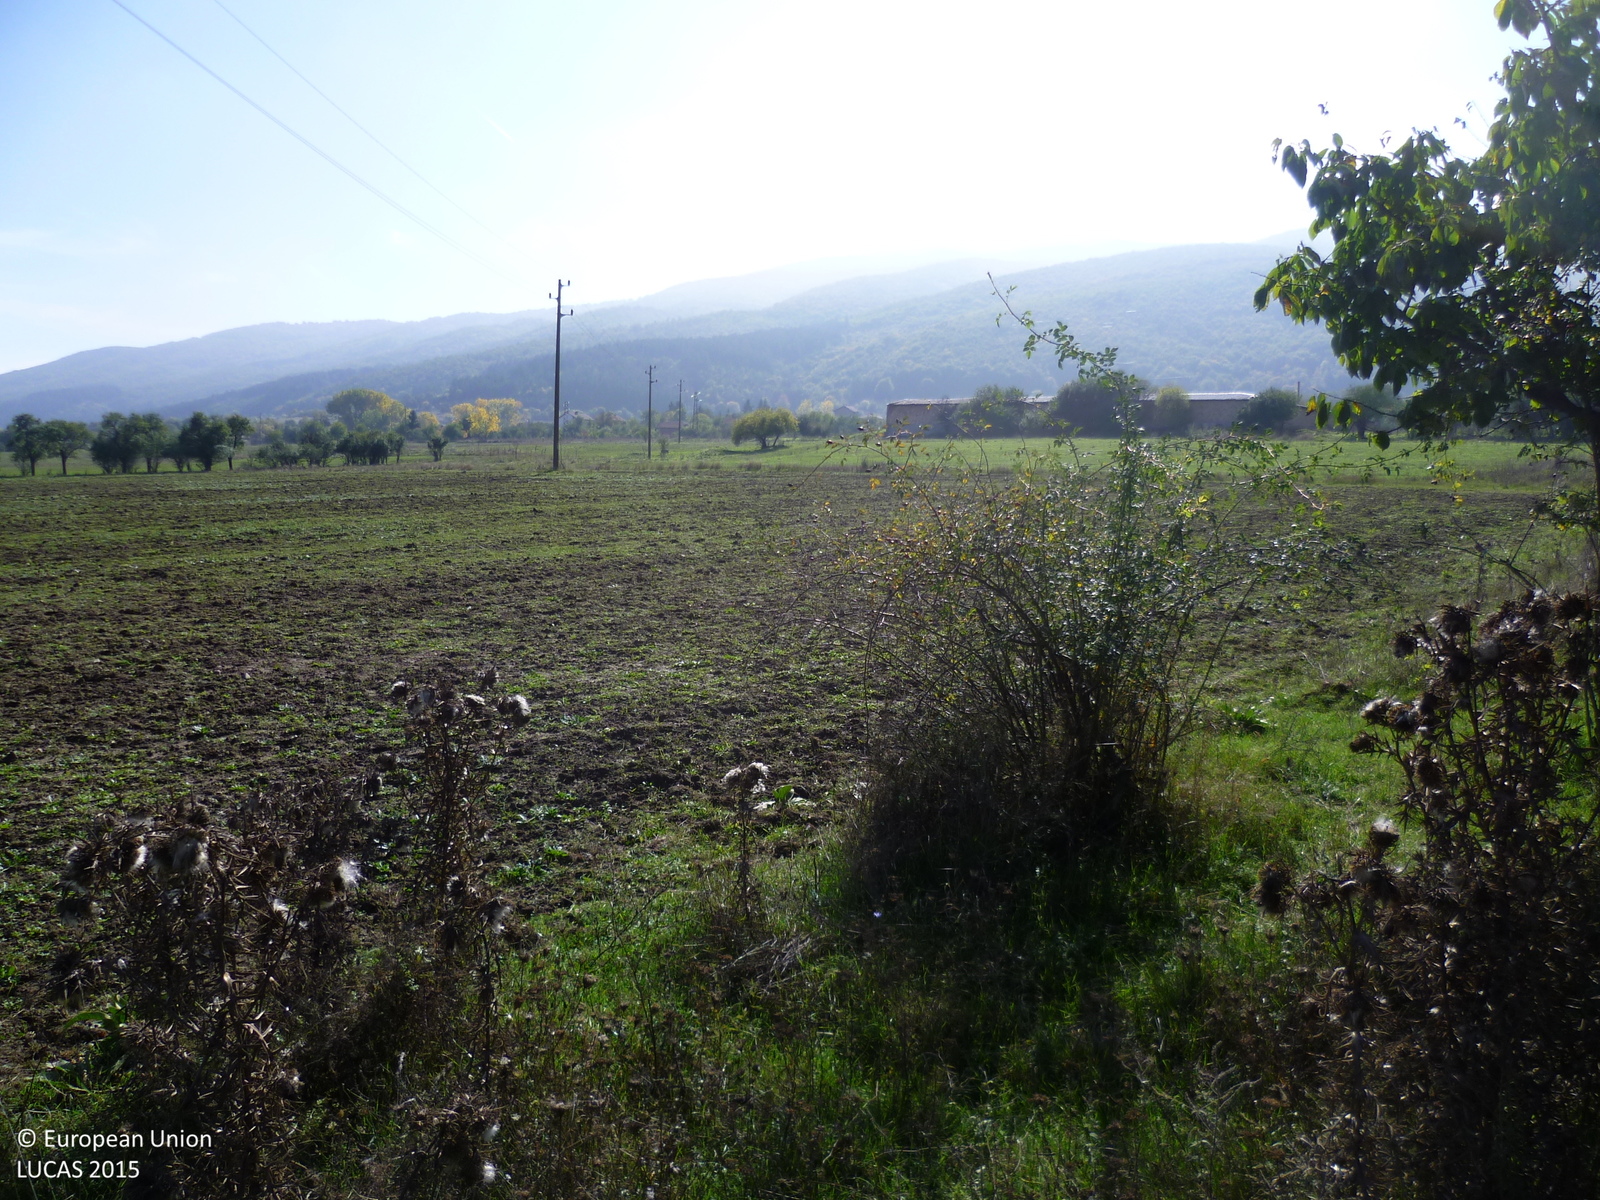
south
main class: Cropland
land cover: Cherry fruit
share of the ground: 50 - 75 %
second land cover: Grassland without tree/shrub cover
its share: > 75 %
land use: Agriculture (excluding fallow land and kitchen gardens)
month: October
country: BG
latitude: 42.4266
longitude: 23.7356
